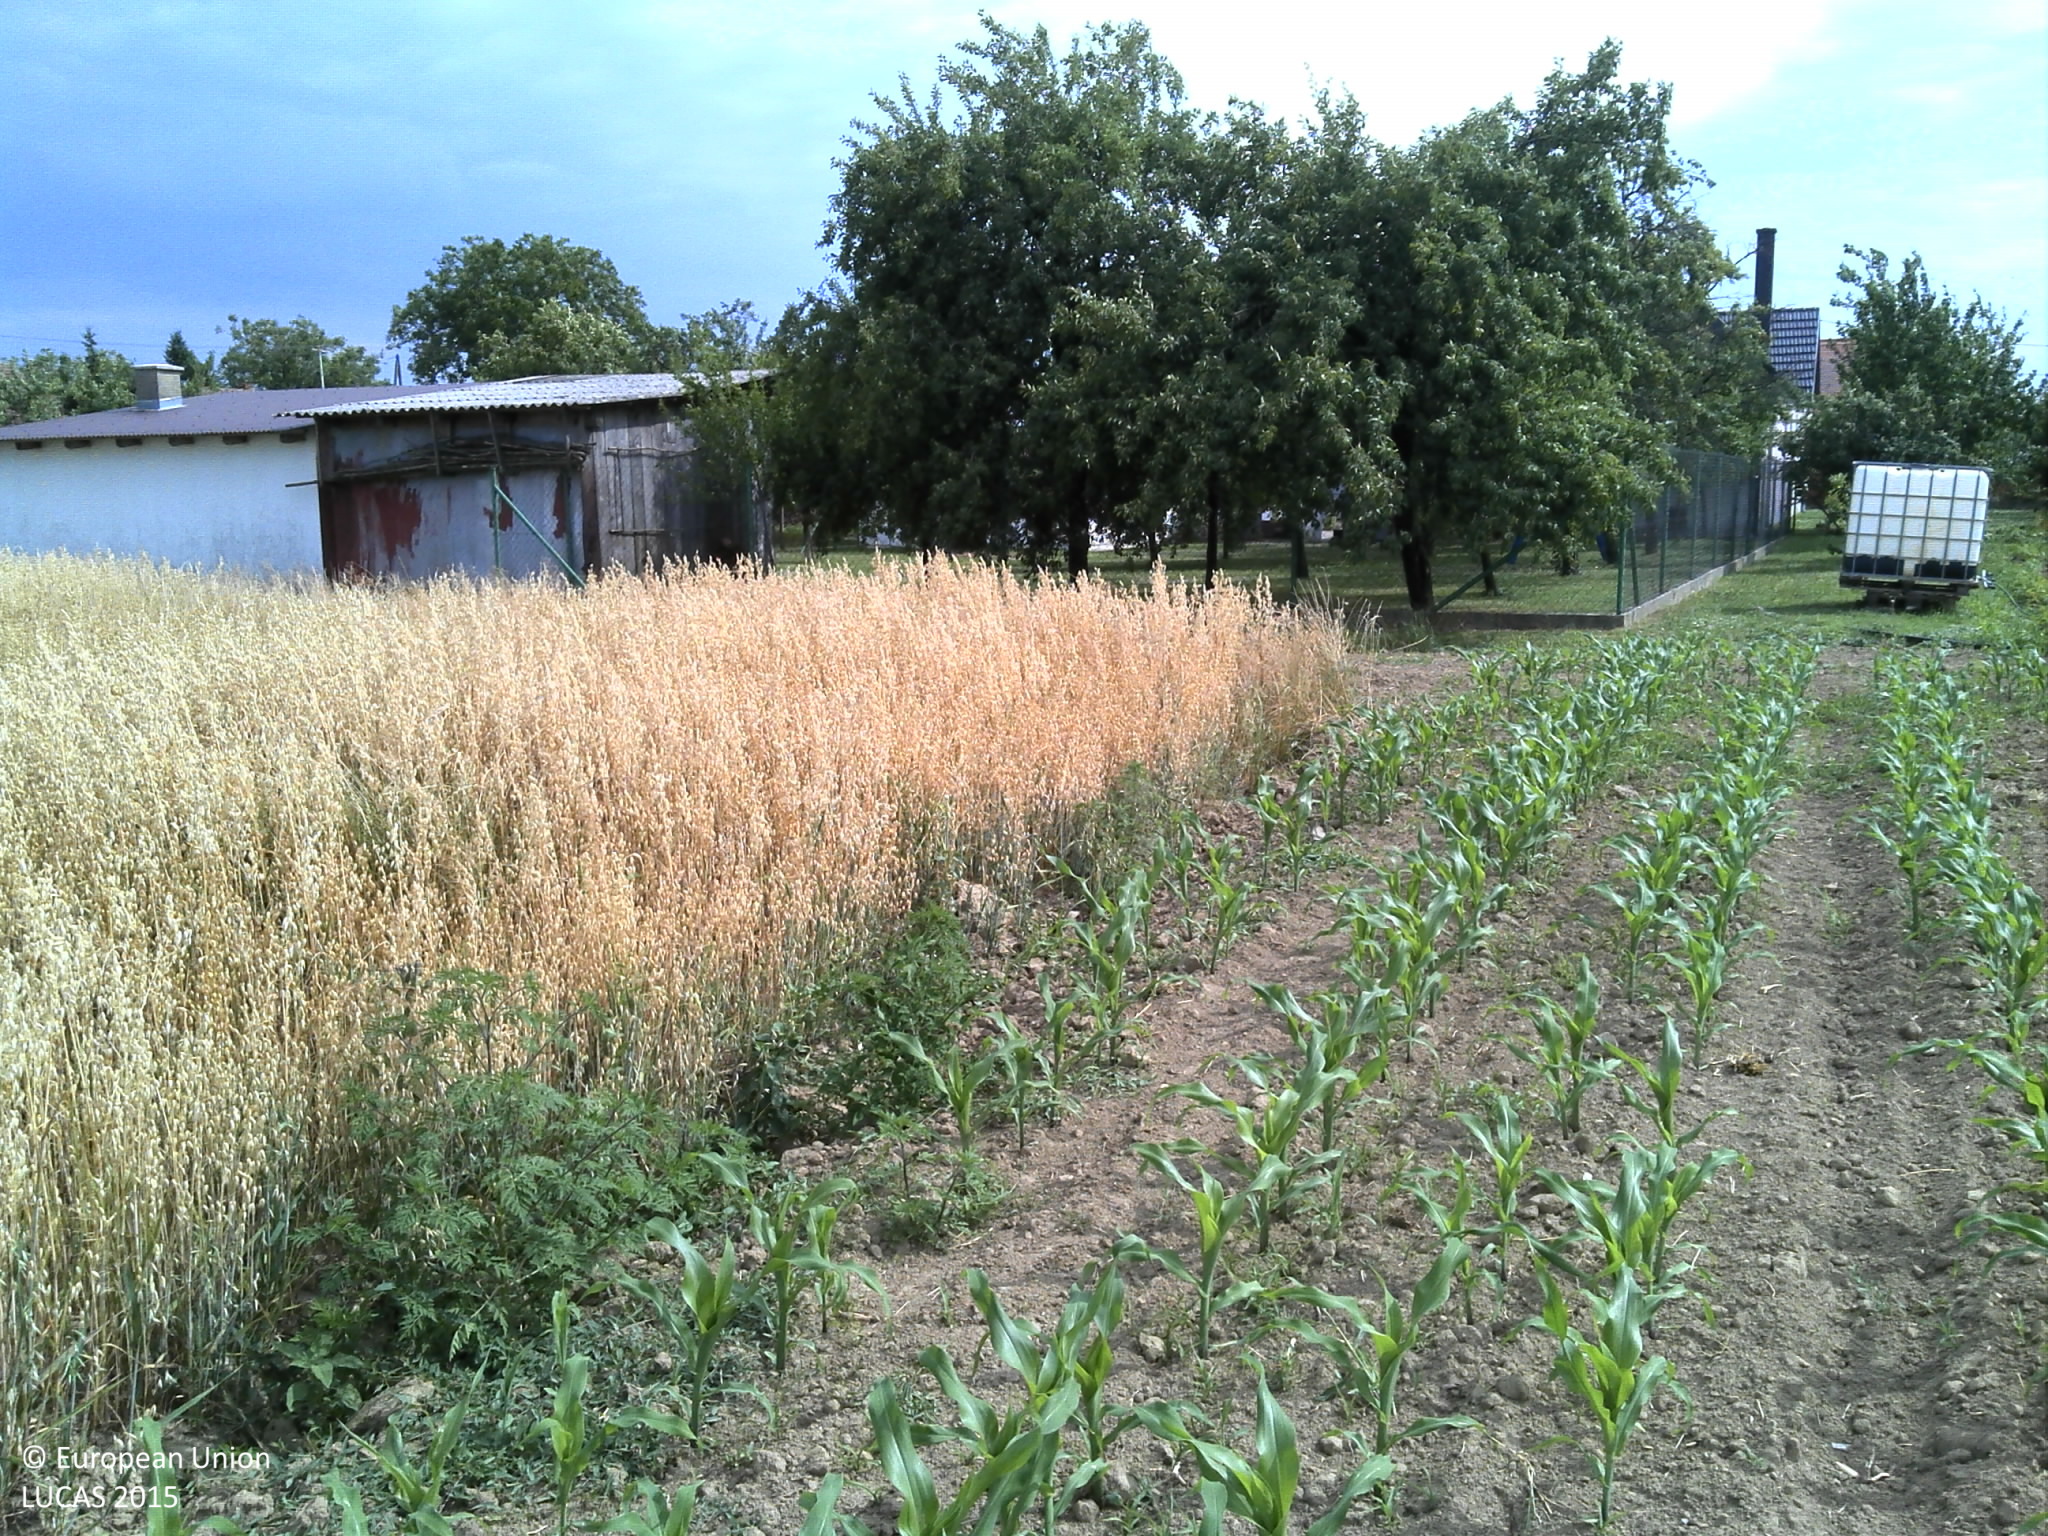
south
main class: Cropland
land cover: Maize
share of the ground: 10 - 25 %
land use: Agriculture (excluding fallow land and kitchen gardens)
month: June
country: HR
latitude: 45.3848
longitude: 18.4219
